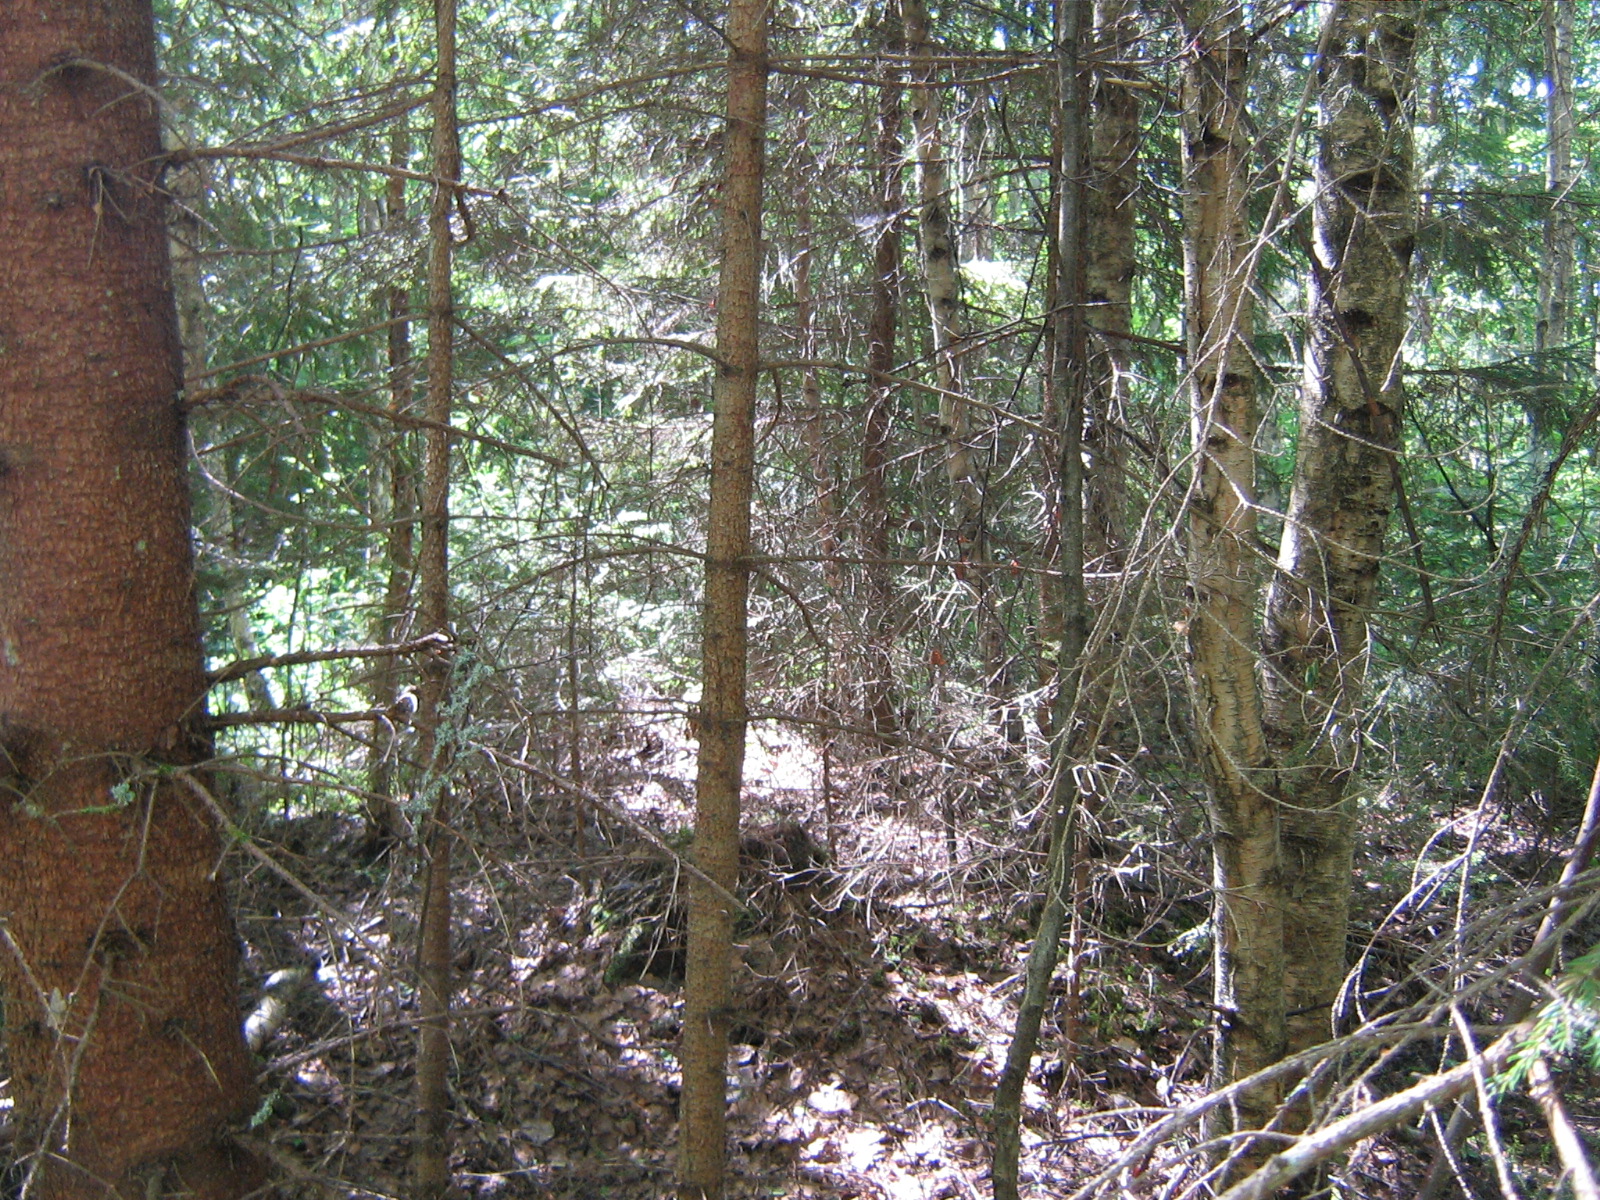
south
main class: Woodland
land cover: Spruce dominated mixed woodland
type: hemiboreal forest and nemoral coniferous forest and mixed broadleaved-coniferous forest
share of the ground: > 75 %
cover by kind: coniferous forest trees 60 %, broadleaved forest trees 40 %
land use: Forestry
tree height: > 5 m
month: June
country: LV
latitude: 57.0777
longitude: 25.9161
